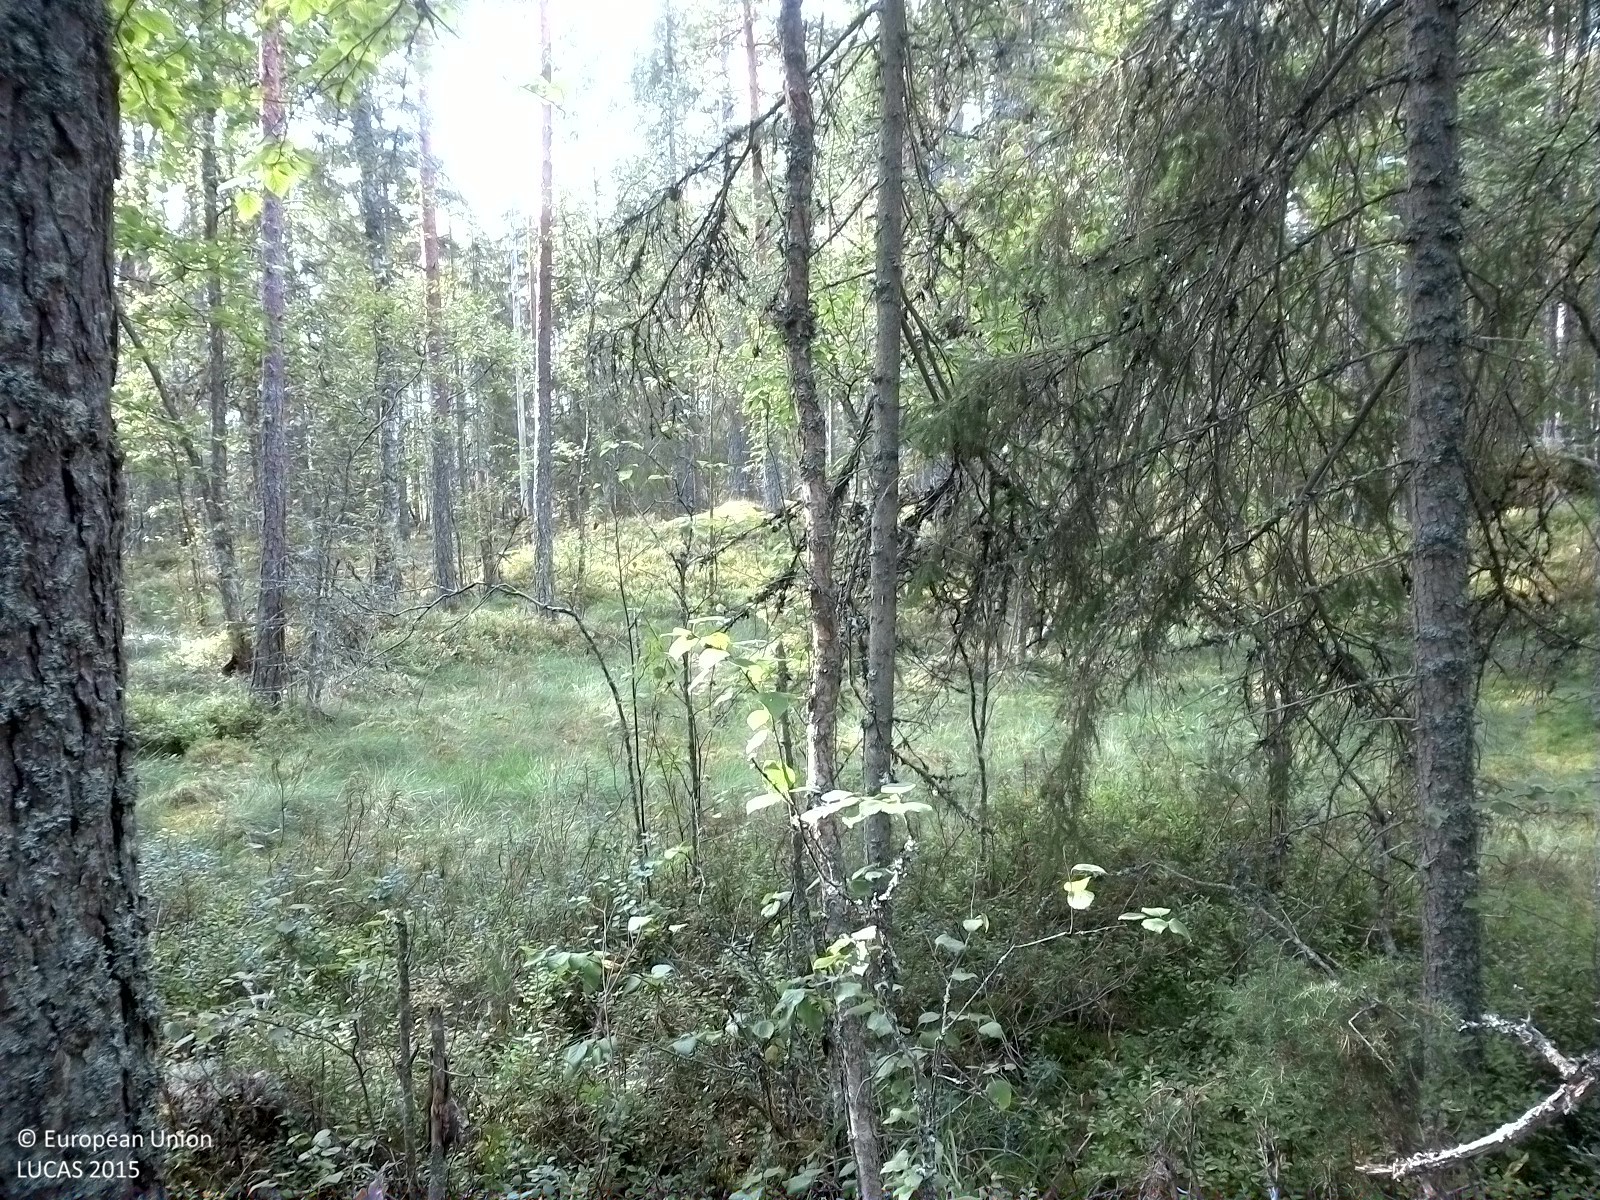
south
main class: Woodland
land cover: Pine dominated coniferous woodland
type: boreal forest
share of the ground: 25 - 50 %
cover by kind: coniferous forest trees 35 %, herbaceous plants 35 %, lichens and mosses 20 %, broadleaved forest trees 5 %, shrubs 5 %
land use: Forestry
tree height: > 5 m
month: August
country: SE
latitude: 58.8098
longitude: 15.5158
